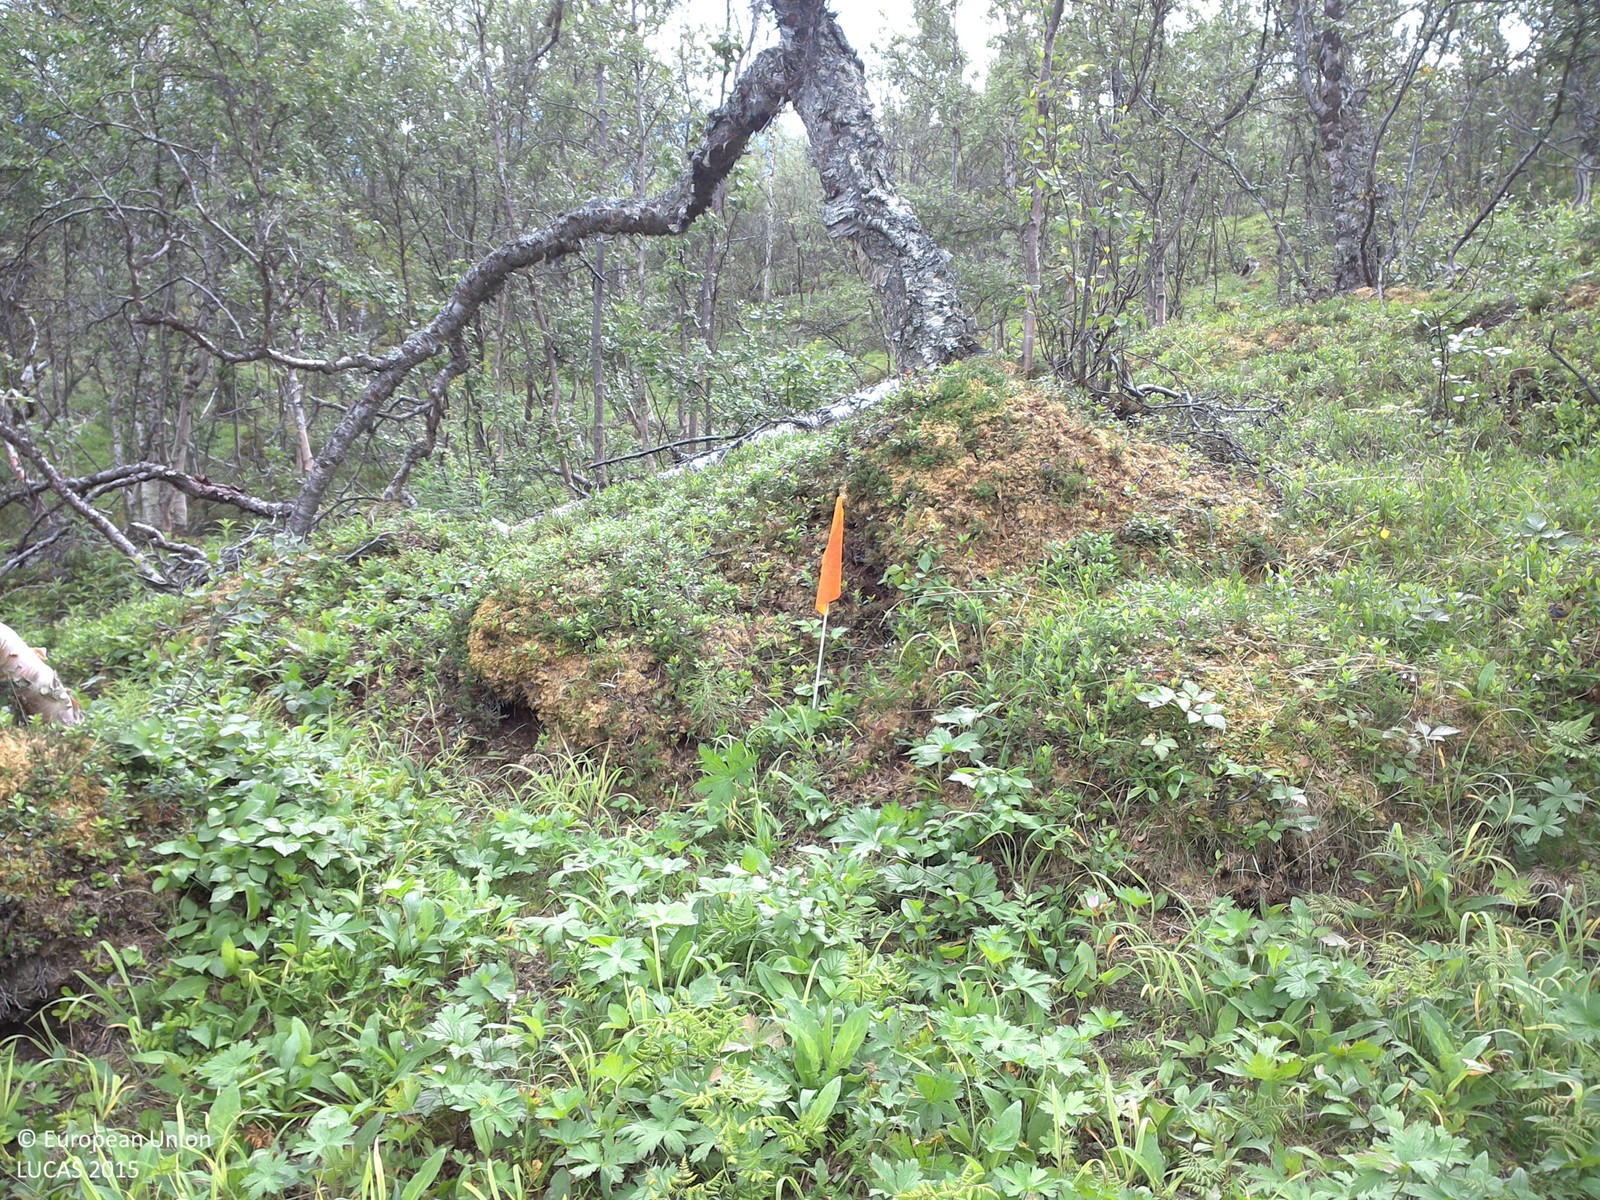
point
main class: Woodland
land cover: Broadleaved woodland
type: boreal forest
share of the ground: 25 - 50 %
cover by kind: shrubs 50 %, broadleaved forest trees 25 %, herbaceous plants 20 %, lichens and mosses 5 %
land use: Amenities, museums, leisure
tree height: > 5 m
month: August
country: SE
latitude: 68.3664
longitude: 18.7549
